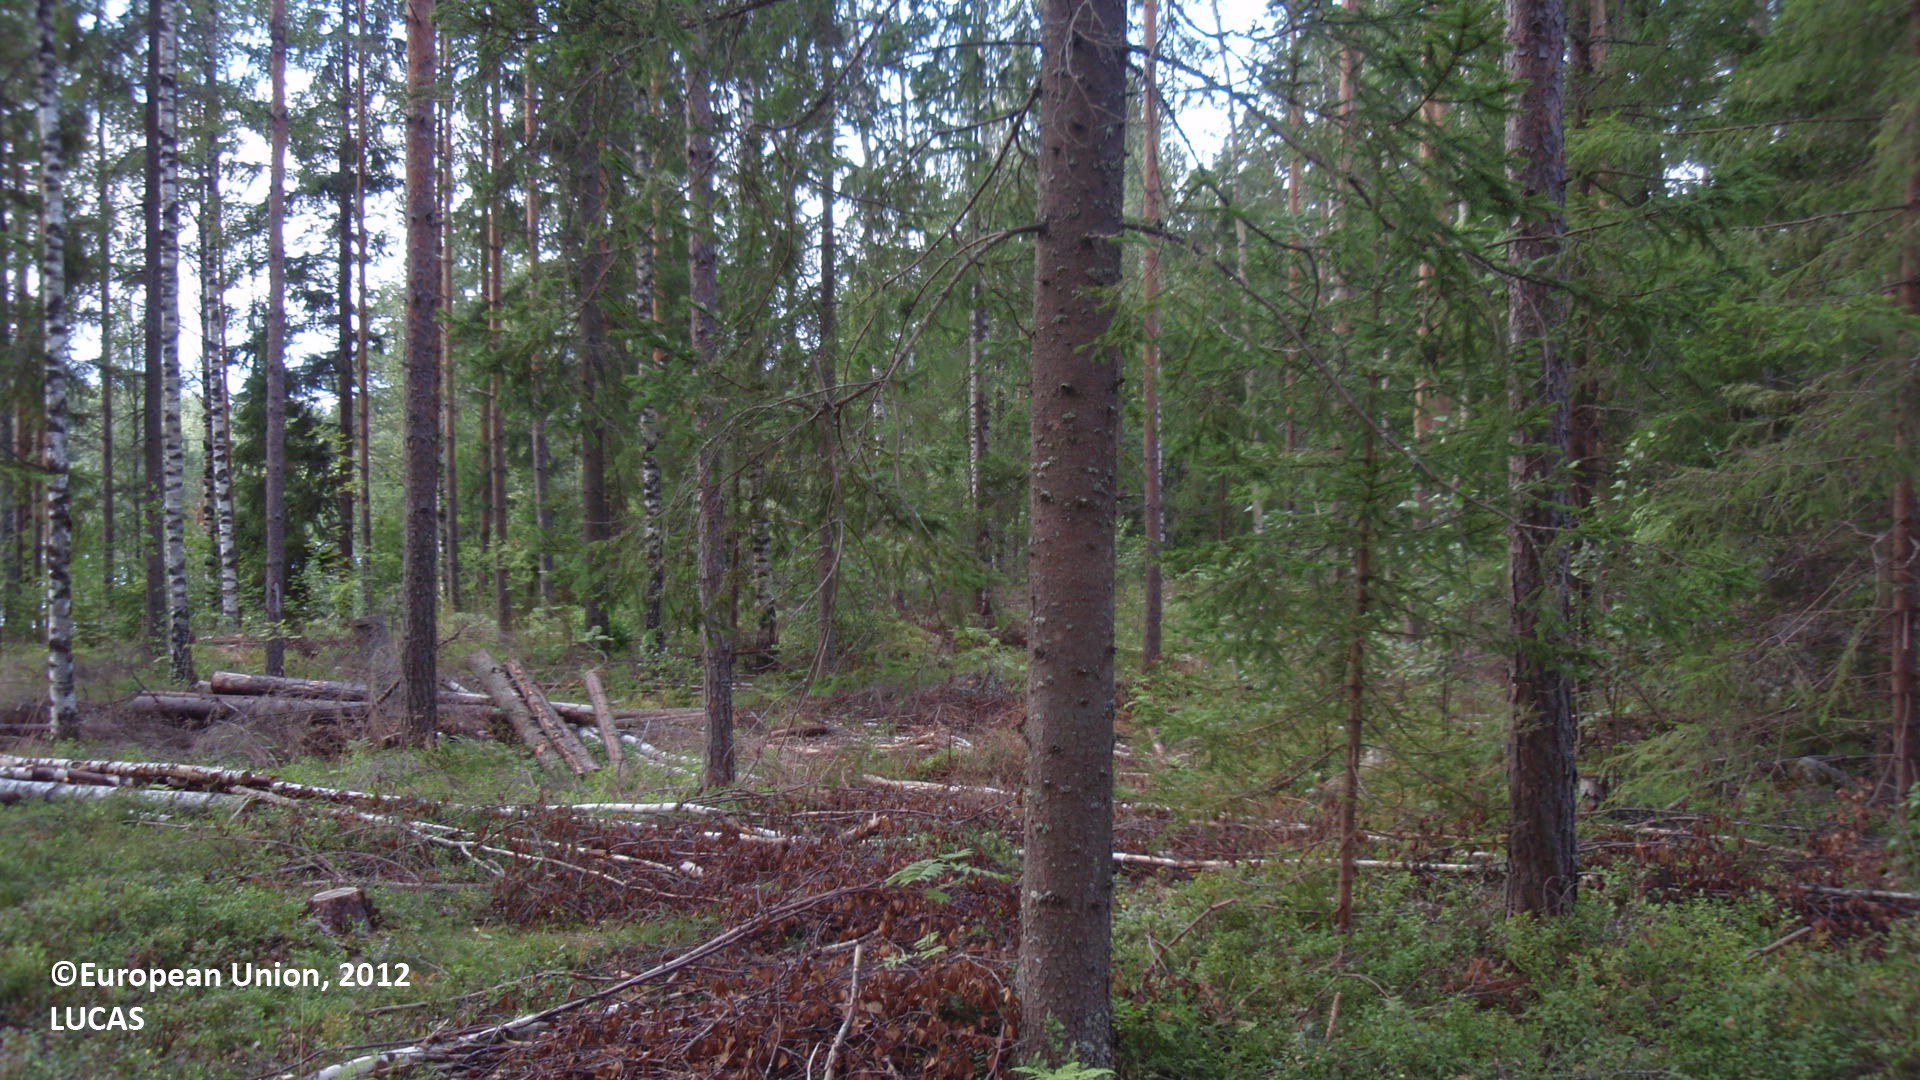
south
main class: Woodland
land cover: Pine dominated mixed woodland
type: boreal forest
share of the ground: 50 - 75 %
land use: Forestry
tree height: > 5 m
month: August
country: FI
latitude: 60.9723
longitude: 27.4168
